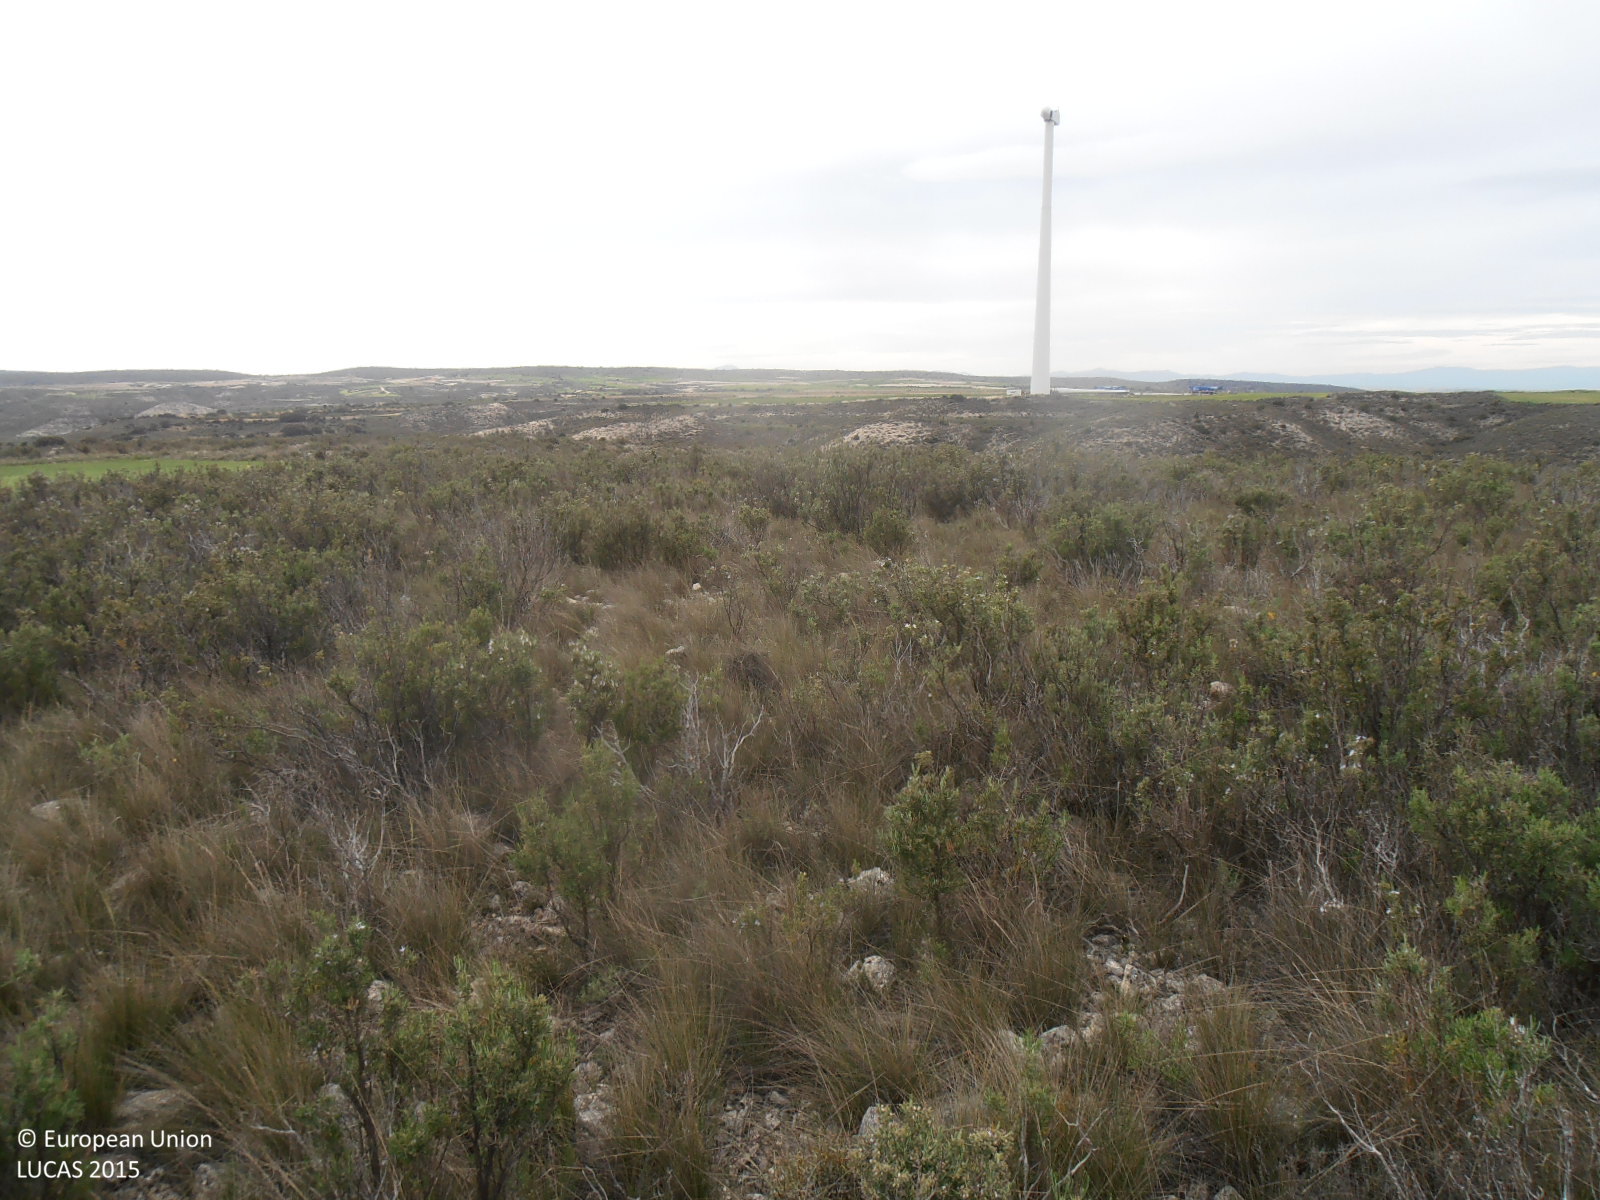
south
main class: Shrubland
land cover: Shrubland without tree cover
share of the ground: > 75 %
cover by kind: shrubs 90 %, herbaceous plants 10 %
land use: Semi-natural and natural areas not in use
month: May
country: ES
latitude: 41.4495
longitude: -1.0216
